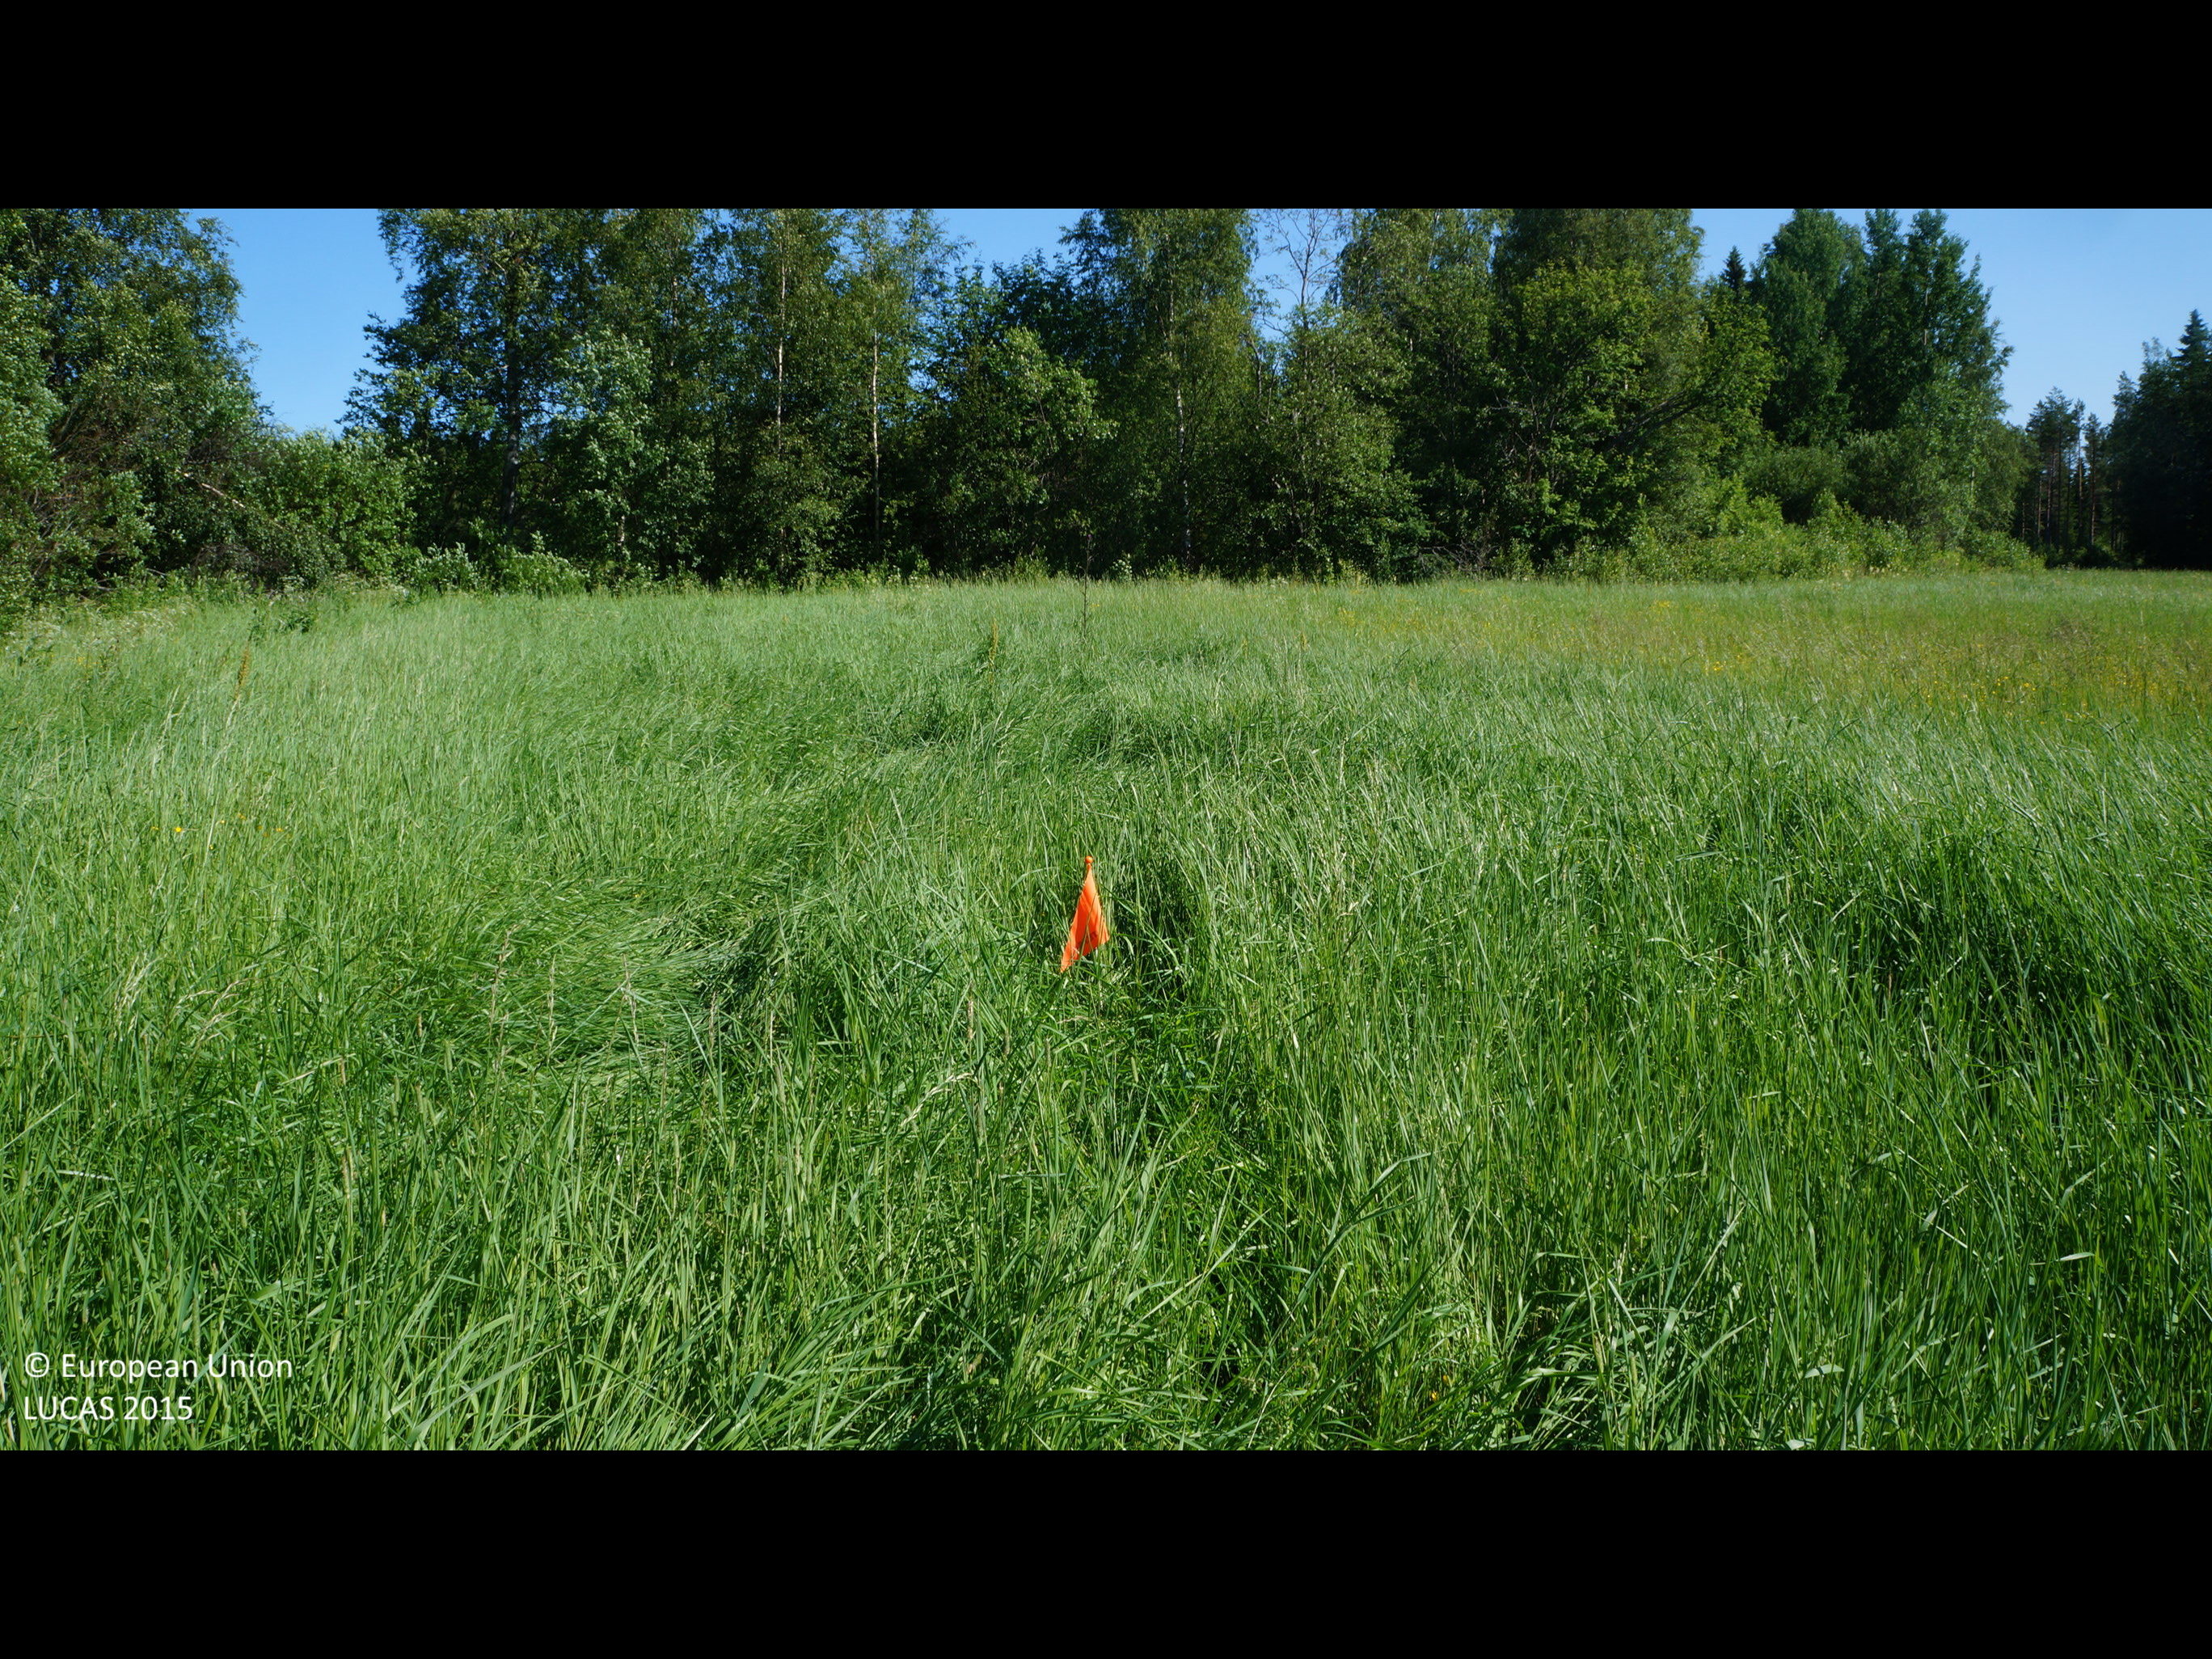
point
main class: Cropland
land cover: Temporary grasslands
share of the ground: > 75 %
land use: Agriculture (excluding fallow land and kitchen gardens)
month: July
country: FI
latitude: 63.8102
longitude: 22.9463
